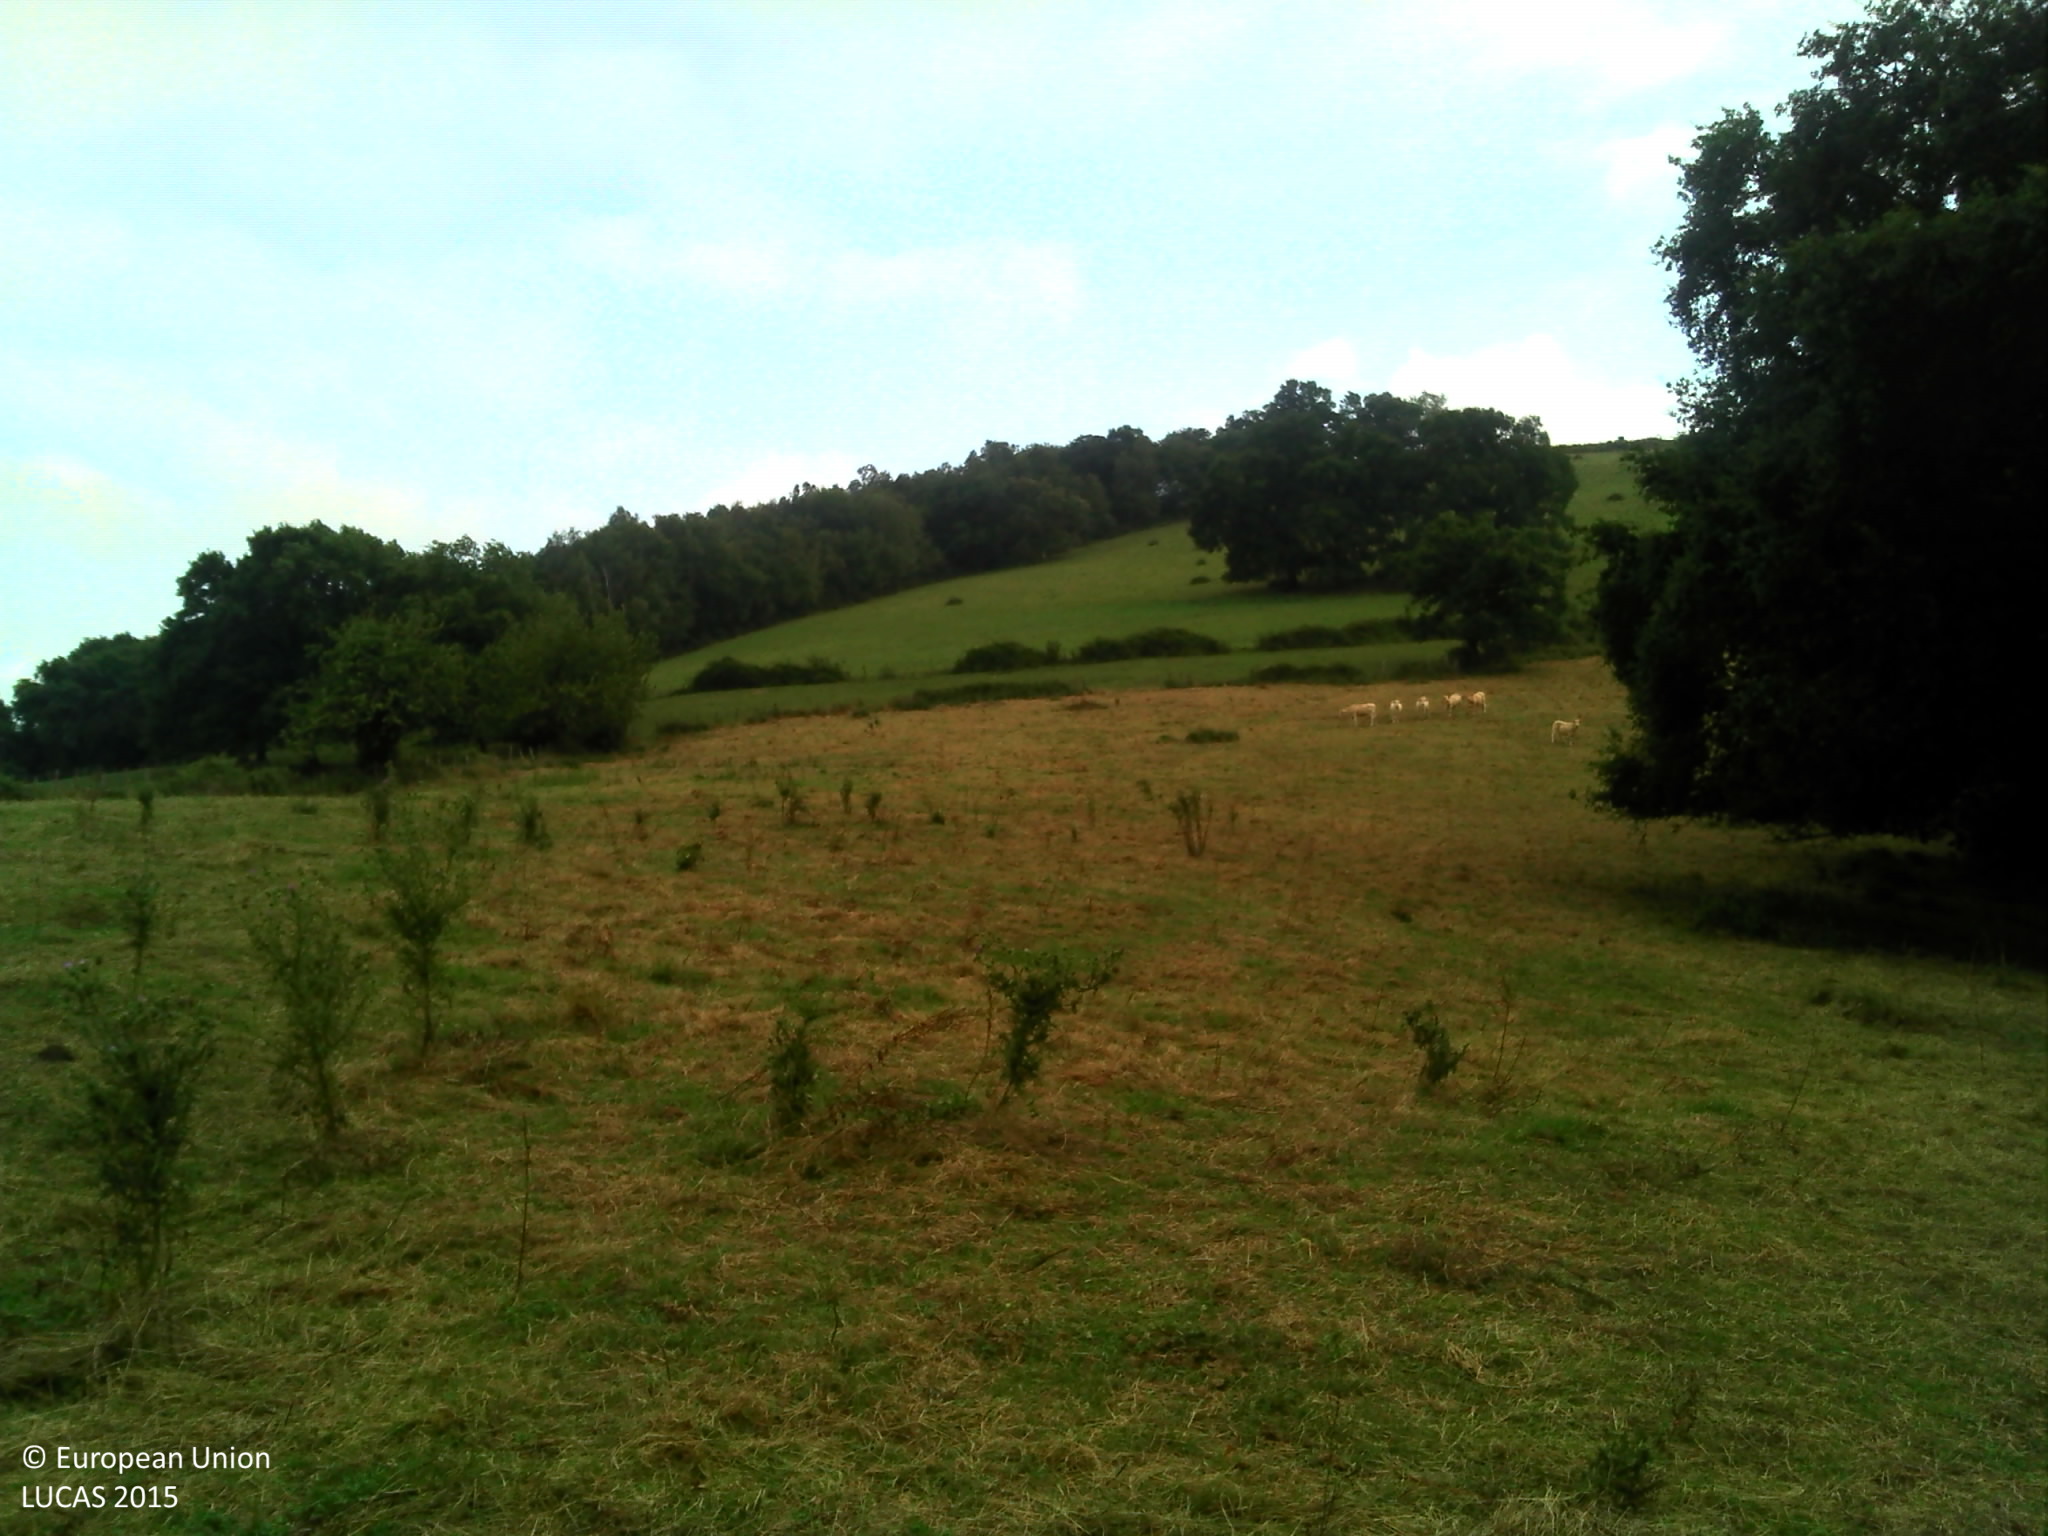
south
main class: Grassland
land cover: Grassland without tree/shrub cover
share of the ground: > 75 %
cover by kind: herbaceous plants 95 %, shrubs 5 %
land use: Agriculture (excluding fallow land and kitchen gardens)
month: August
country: FR
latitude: 43.3523
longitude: -1.1049
